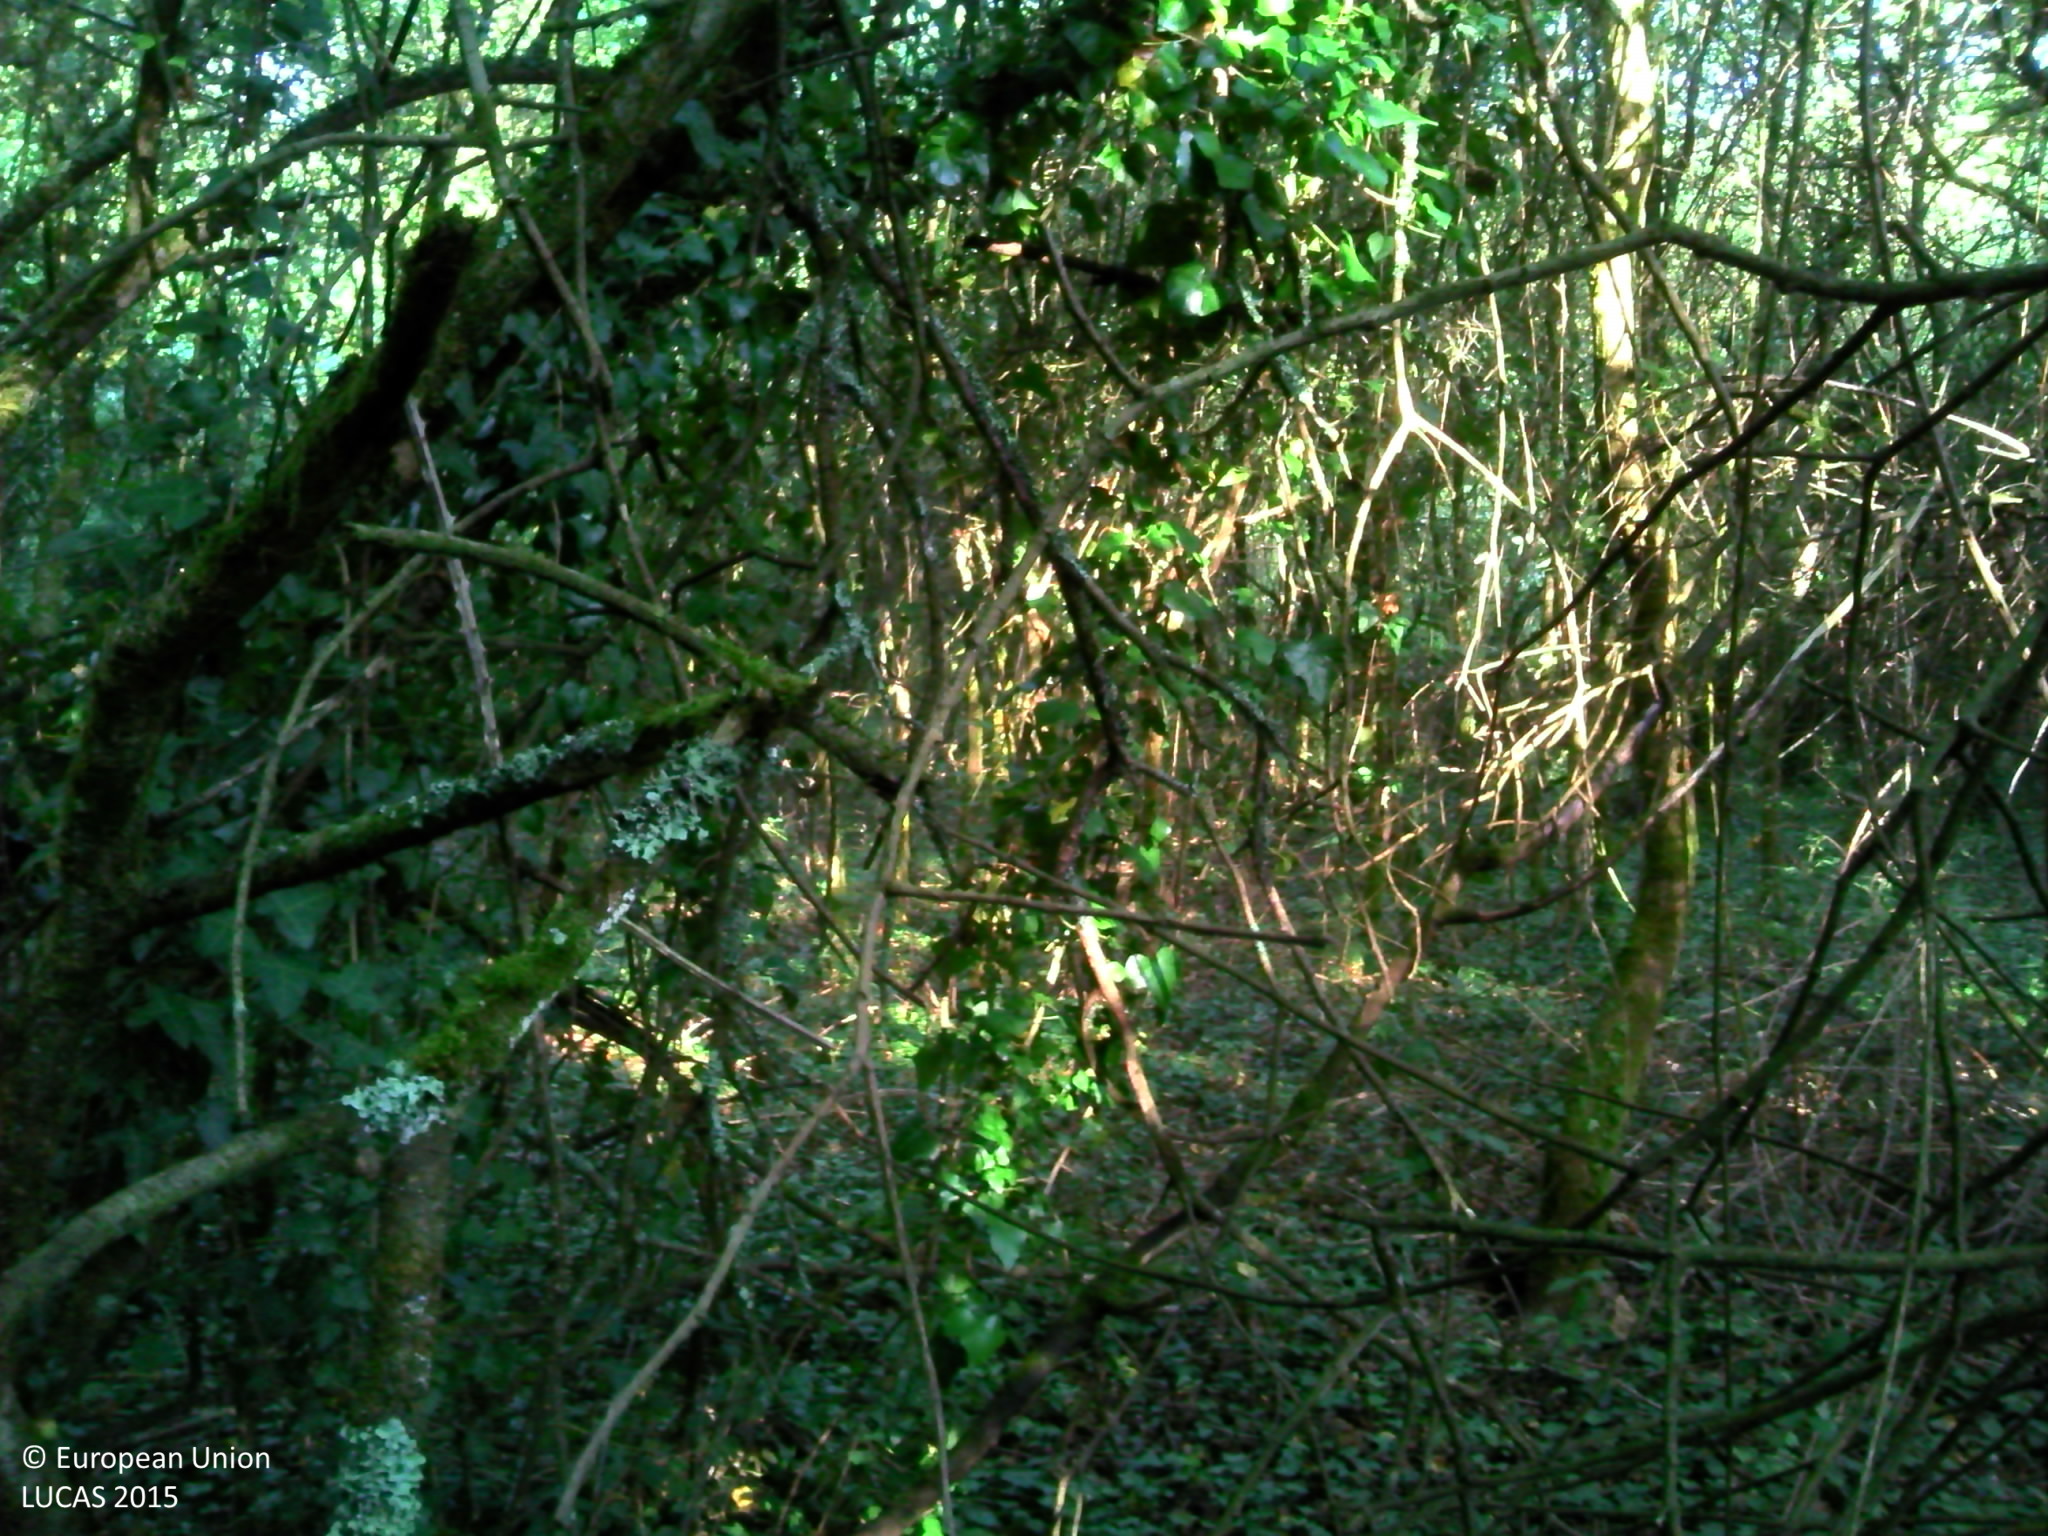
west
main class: Woodland
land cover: Broadleaved woodland
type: mesophytic deciduous forest
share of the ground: > 75 %
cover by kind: broadleaved forest trees 95 %, herbaceous plants 5 %
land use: Semi-natural and natural areas not in use
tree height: > 5 m
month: August
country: FR
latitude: 47.3584
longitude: -1.8970
